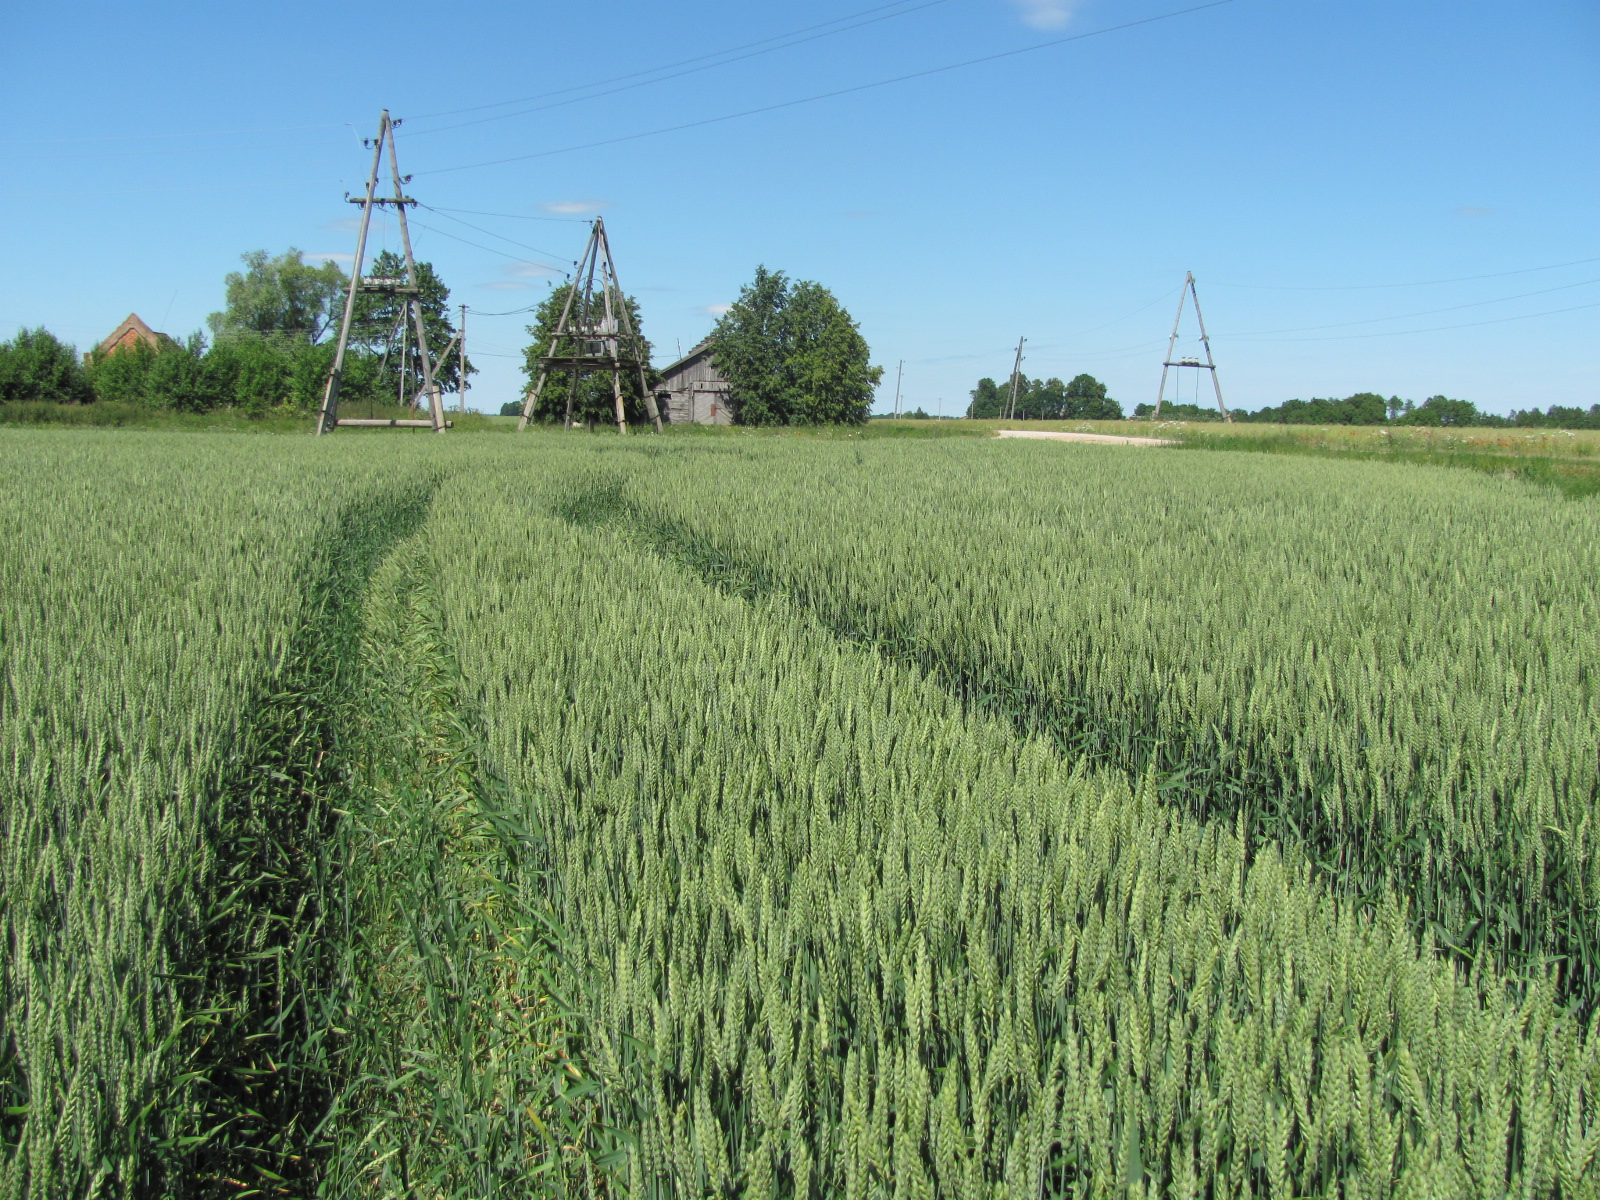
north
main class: Cropland
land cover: Common wheat
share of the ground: > 75 %
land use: Agriculture (excluding fallow land and kitchen gardens)
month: July
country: LV
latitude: 56.4471
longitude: 23.7561
